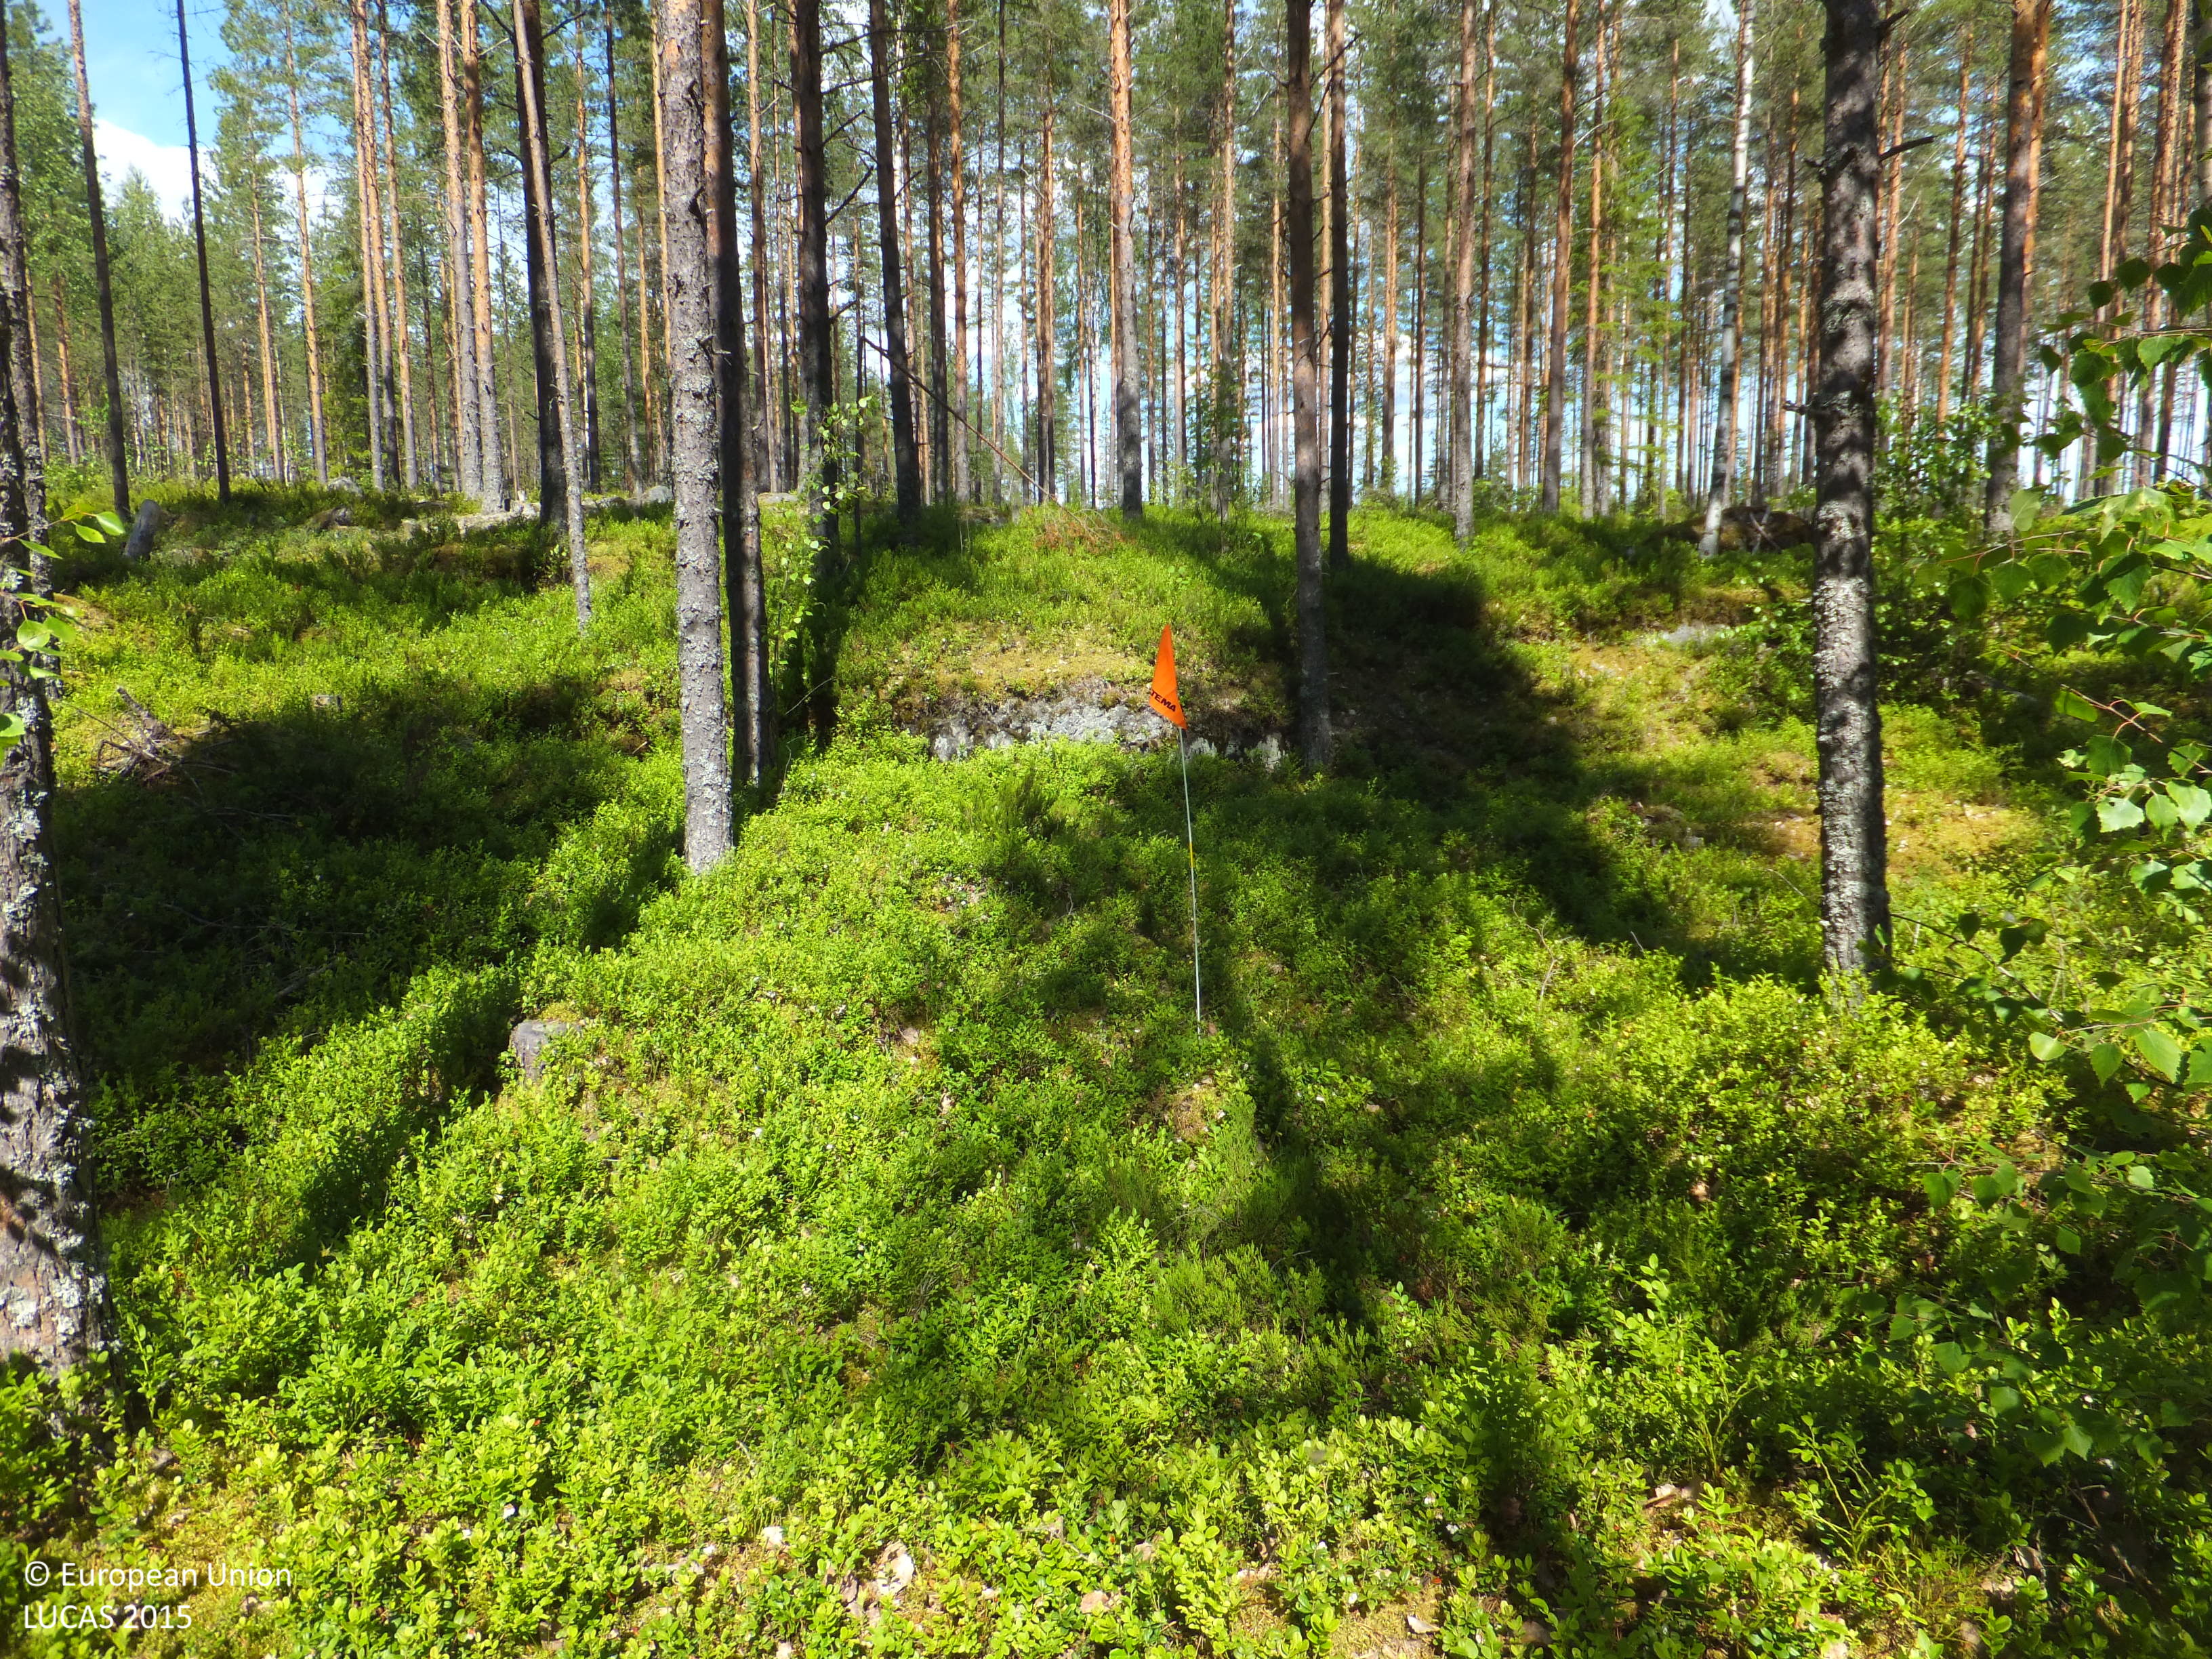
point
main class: Woodland
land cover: Pine dominated mixed woodland
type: boreal forest
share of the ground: 50 - 75 %
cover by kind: coniferous forest trees 40 %, shrubs 25 %, broadleaved forest trees 15 %, lichens and mosses 15 %, consolidated bare surface 5 %
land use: Forestry
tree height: > 5 m
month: July
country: FI
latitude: 63.0439
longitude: 23.9349
